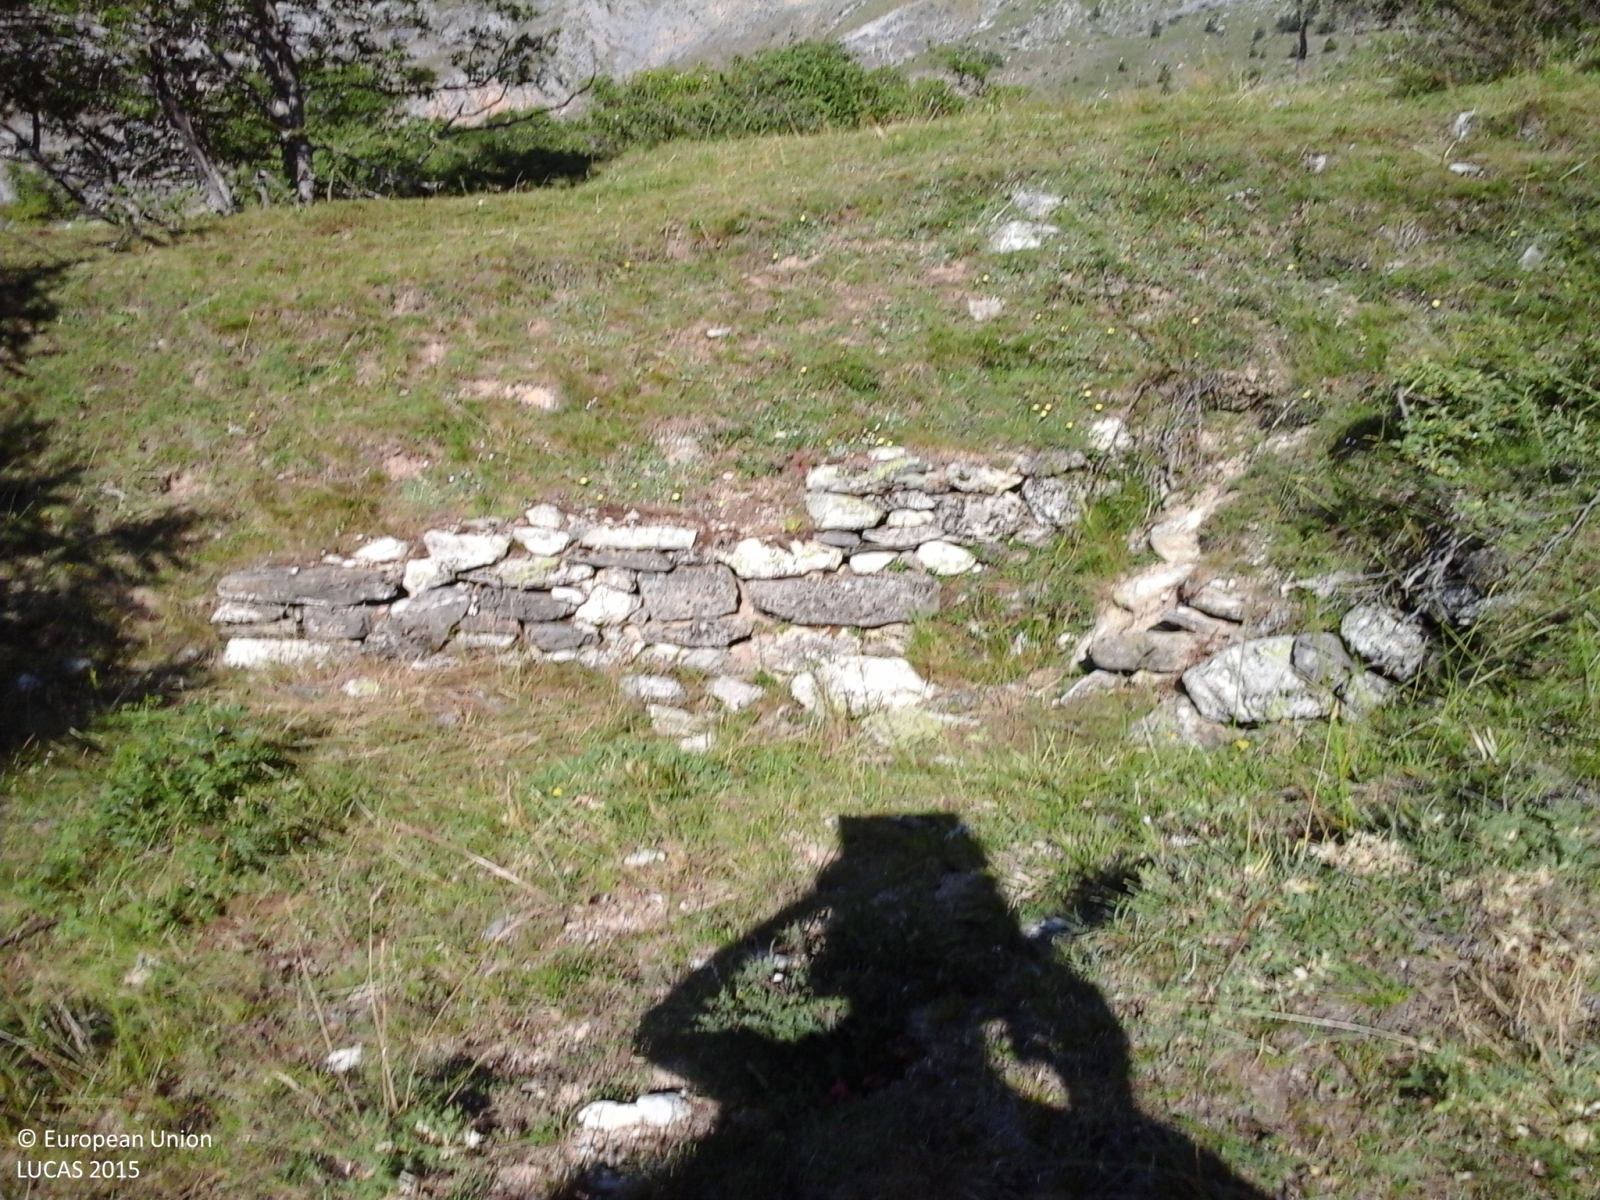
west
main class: Grassland
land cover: Grassland without tree/shrub cover
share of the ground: > 75 %
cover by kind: herbaceous plants 90 %, consolidated bare surface 10 %
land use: Agriculture (excluding fallow land and kitchen gardens)
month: July
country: IT
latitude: 44.4870
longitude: 6.9755
